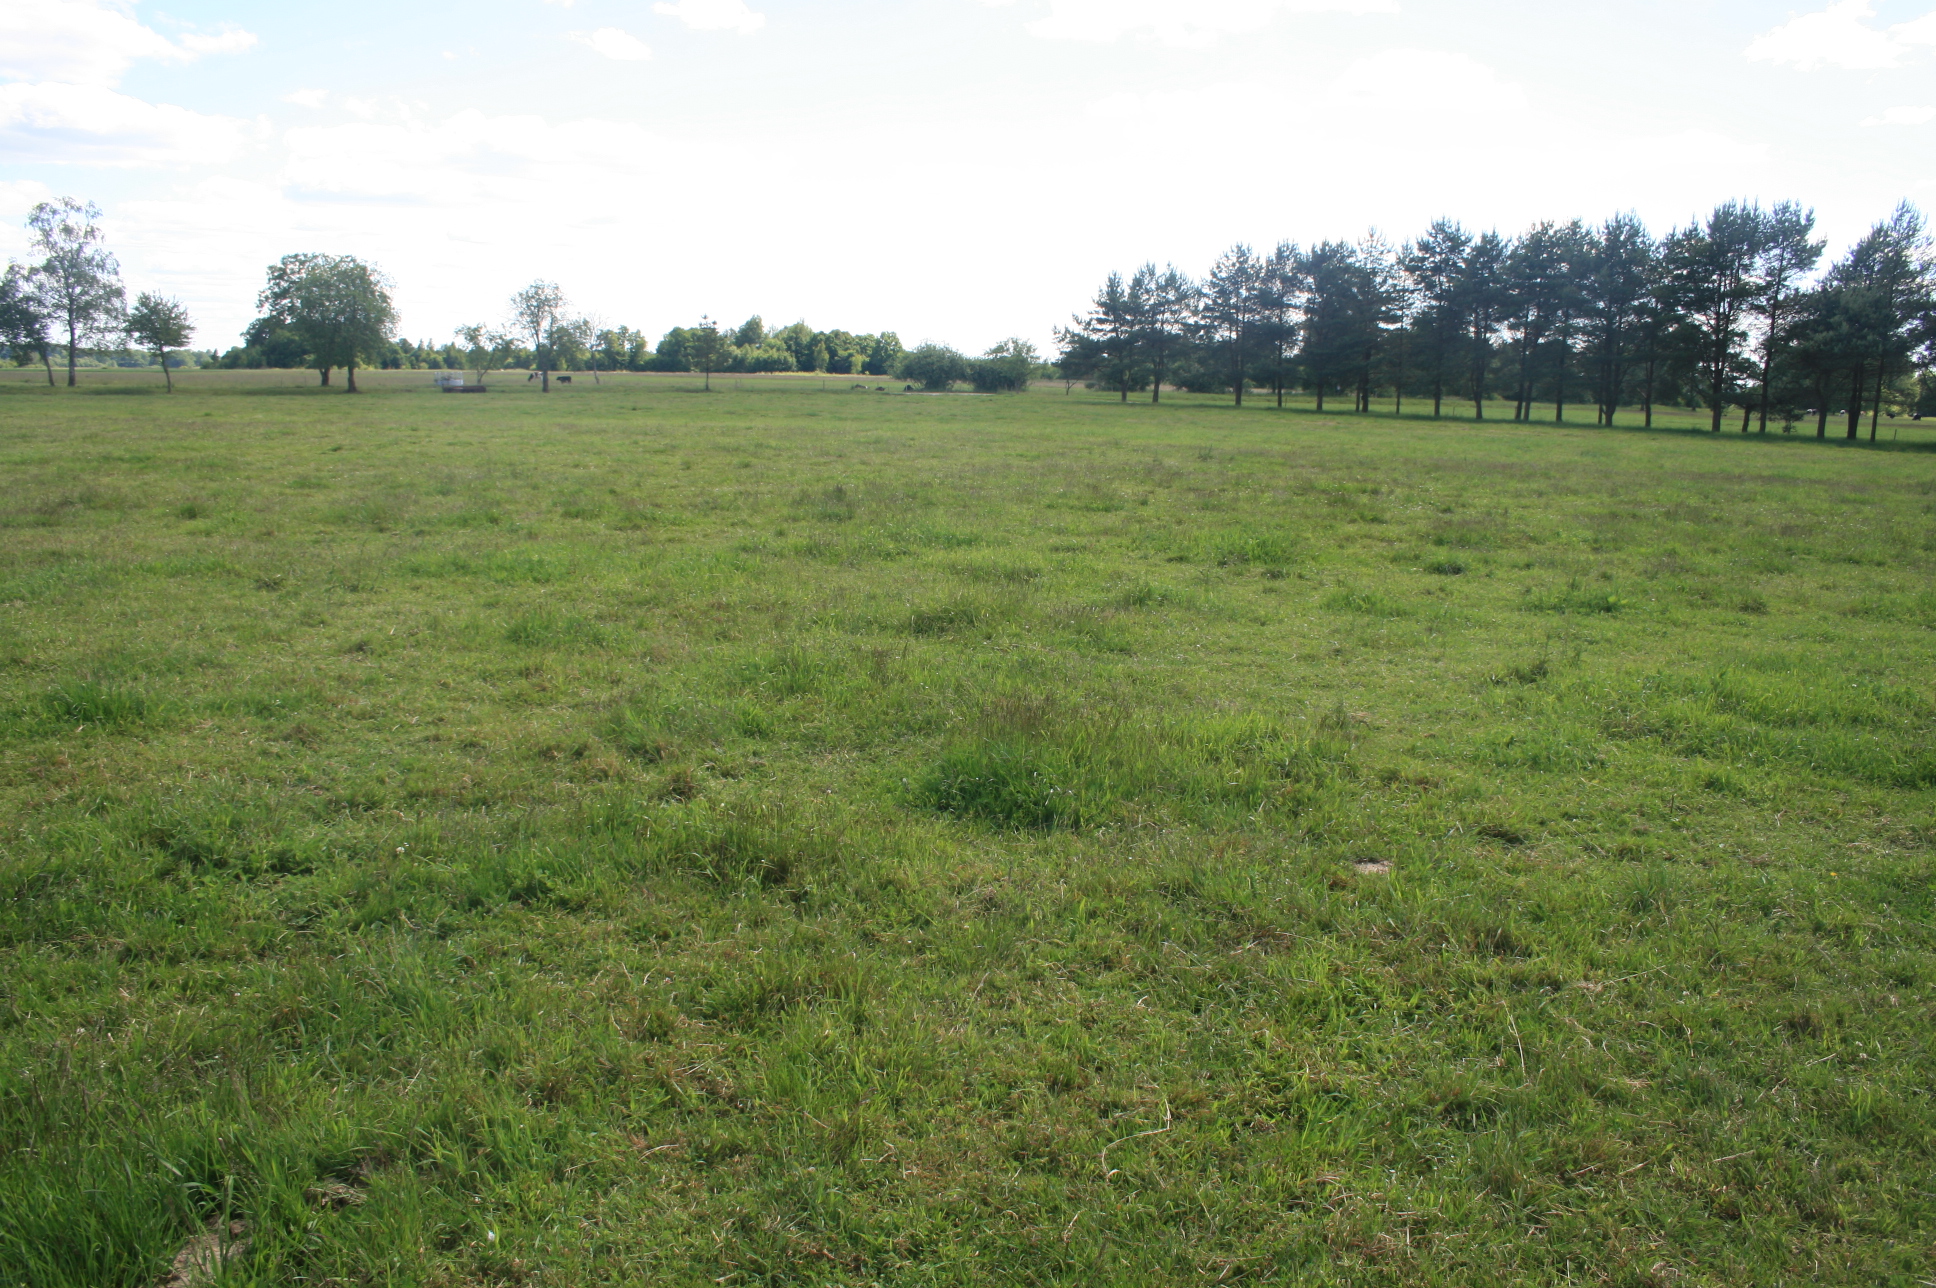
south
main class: Grassland
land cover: Grassland without tree/shrub cover
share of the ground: > 75 %
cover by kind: herbaceous plants 100 %
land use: Agriculture (excluding fallow land and kitchen gardens)
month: June
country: LT
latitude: 55.4177
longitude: 22.0445
